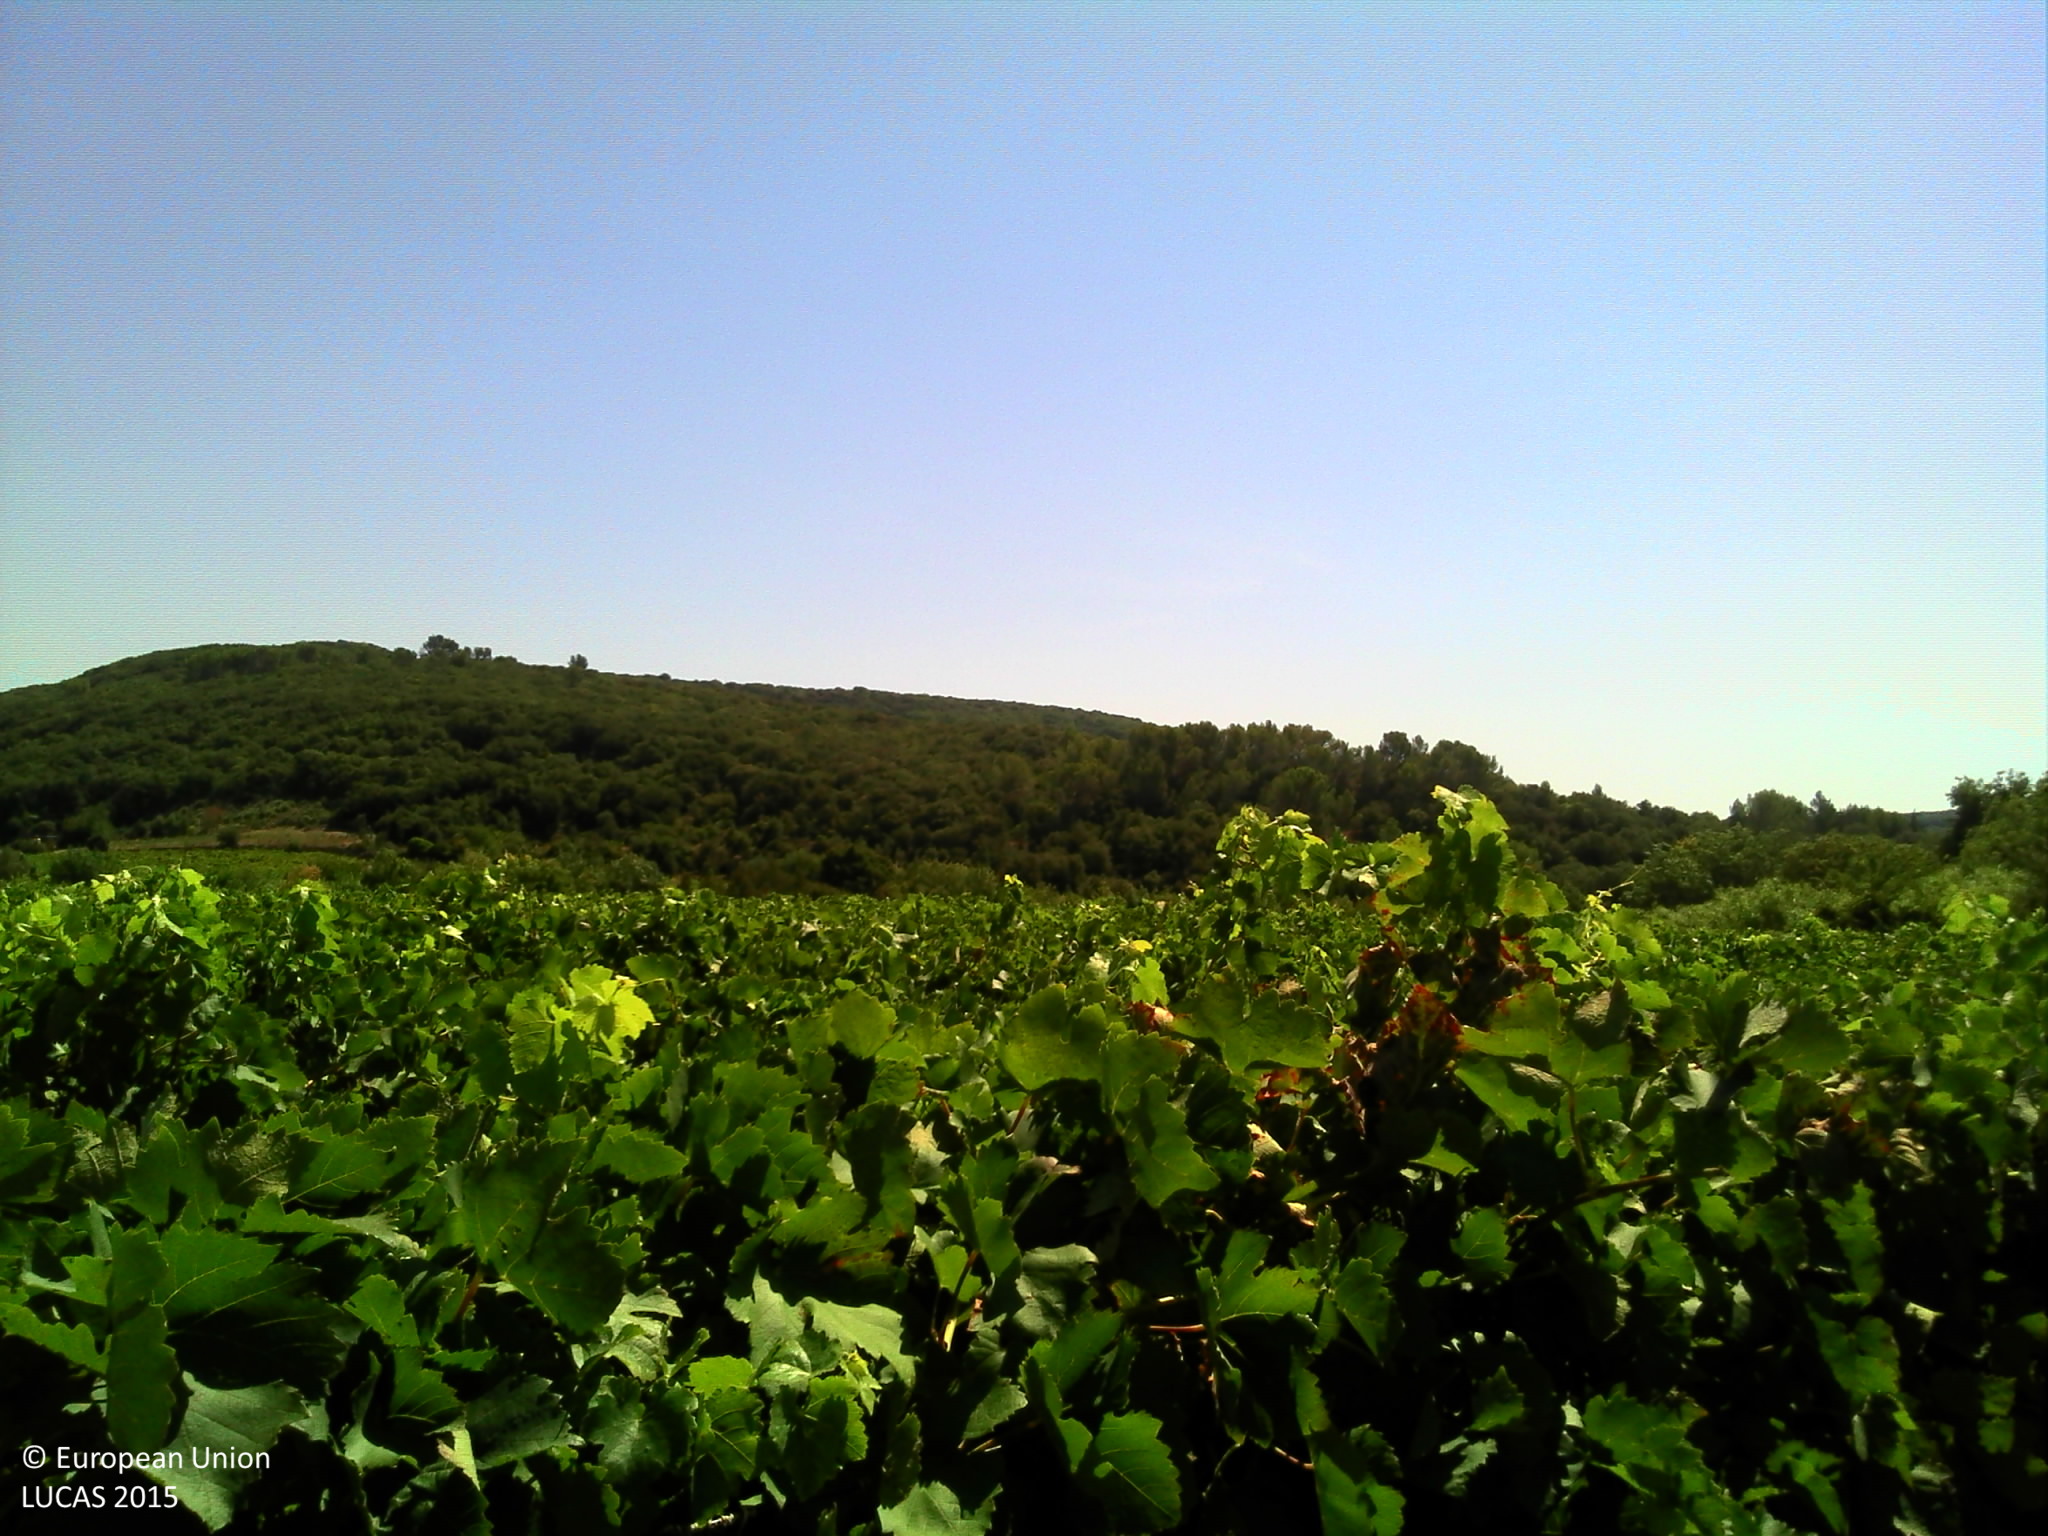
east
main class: Cropland
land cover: Vineyards
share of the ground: 10 - 25 %
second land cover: Other bare soil
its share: > 75 %
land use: Agriculture (excluding fallow land and kitchen gardens)
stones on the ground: 25 - 50 %
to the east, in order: Vineyards; Other bare soil; Tracks; Lines of trees; Vineyards; Tracks; Fences; Other fresh vegetables; Fences; Tracks; Broadleaved woodland
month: August
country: FR
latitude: 43.5392
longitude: 3.3384
